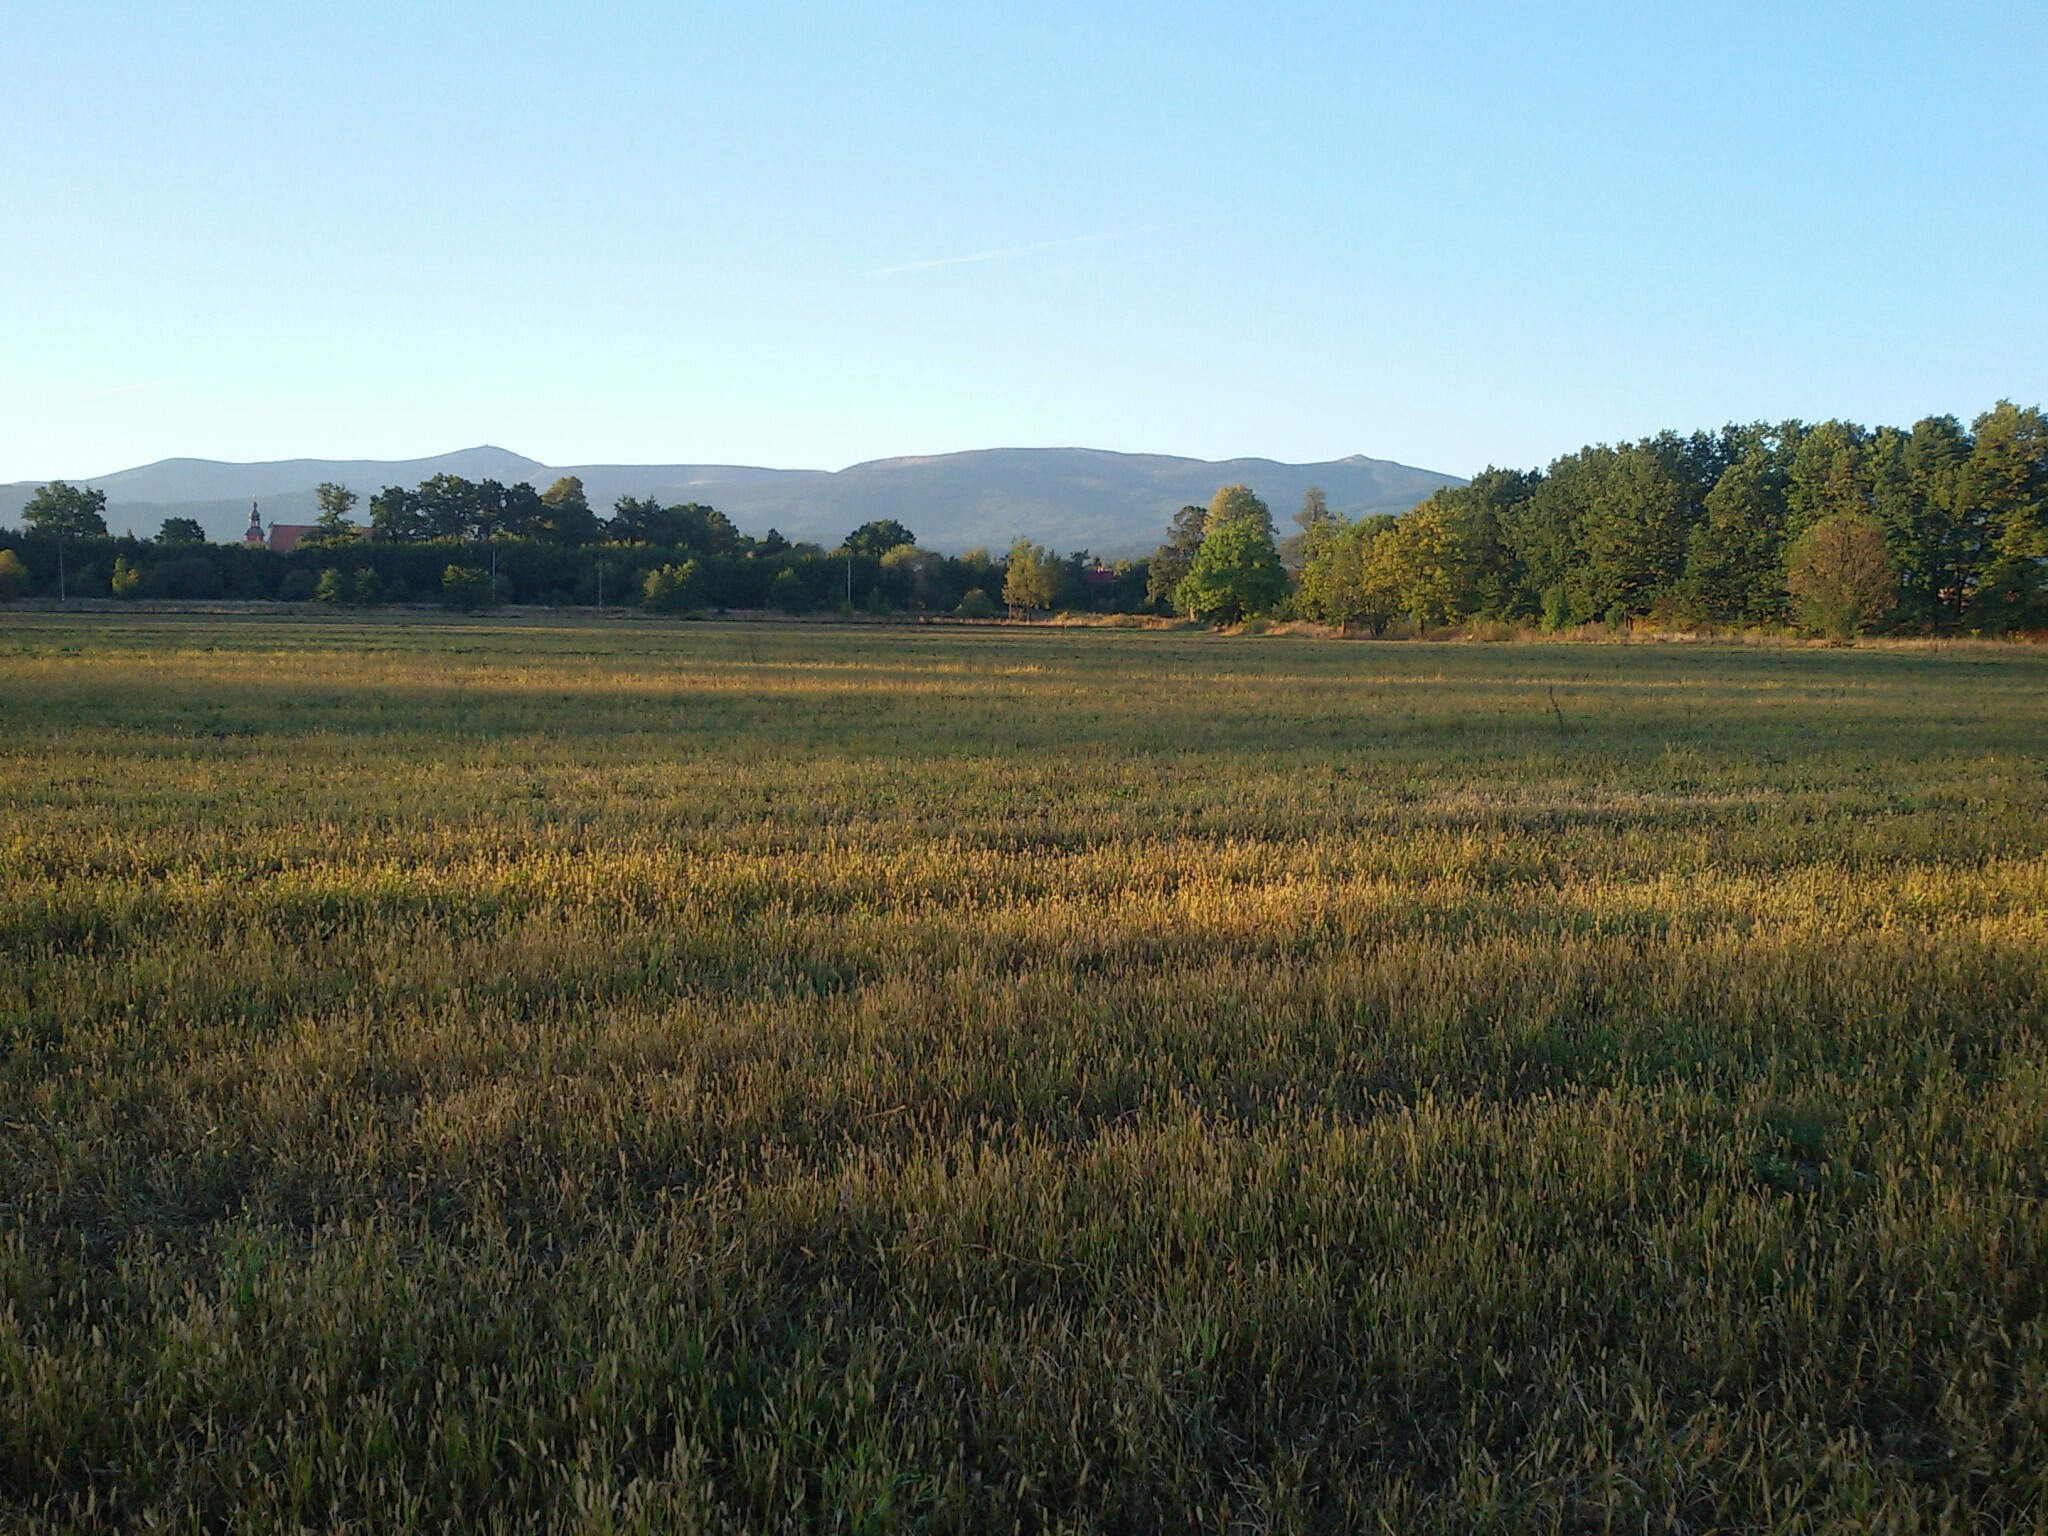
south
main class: Grassland
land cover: Spontaneously vegetated surfaces
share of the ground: > 75 %
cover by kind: herbaceous plants 95 %, unconsolidated bare surface 5 %
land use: Fallow land
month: September
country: PL
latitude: 50.8721
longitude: 15.6748
